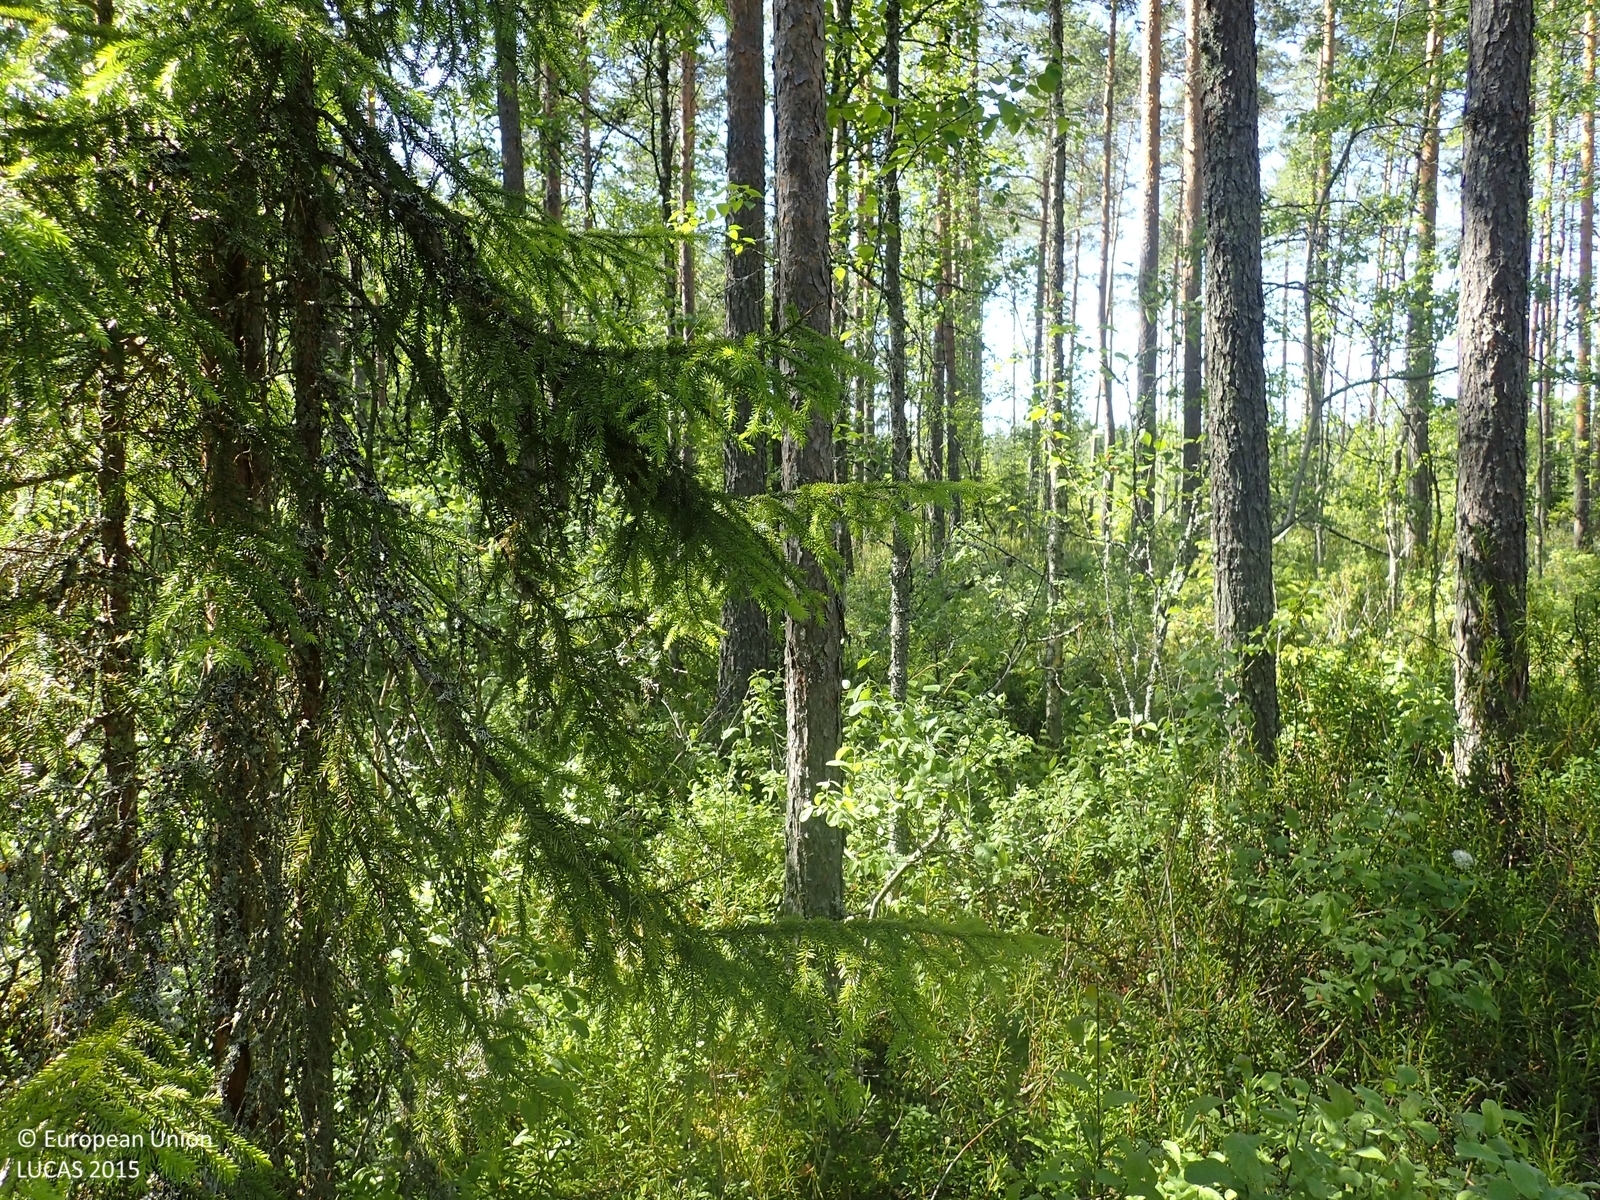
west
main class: Woodland
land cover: Pine dominated coniferous woodland
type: boreal forest
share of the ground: 50 - 75 %
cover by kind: shrubs 50 %, coniferous forest trees 45 %, broadleaved forest trees 5 %
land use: Forestry
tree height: > 5 m
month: July
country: FI
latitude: 62.6041
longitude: 21.5561
